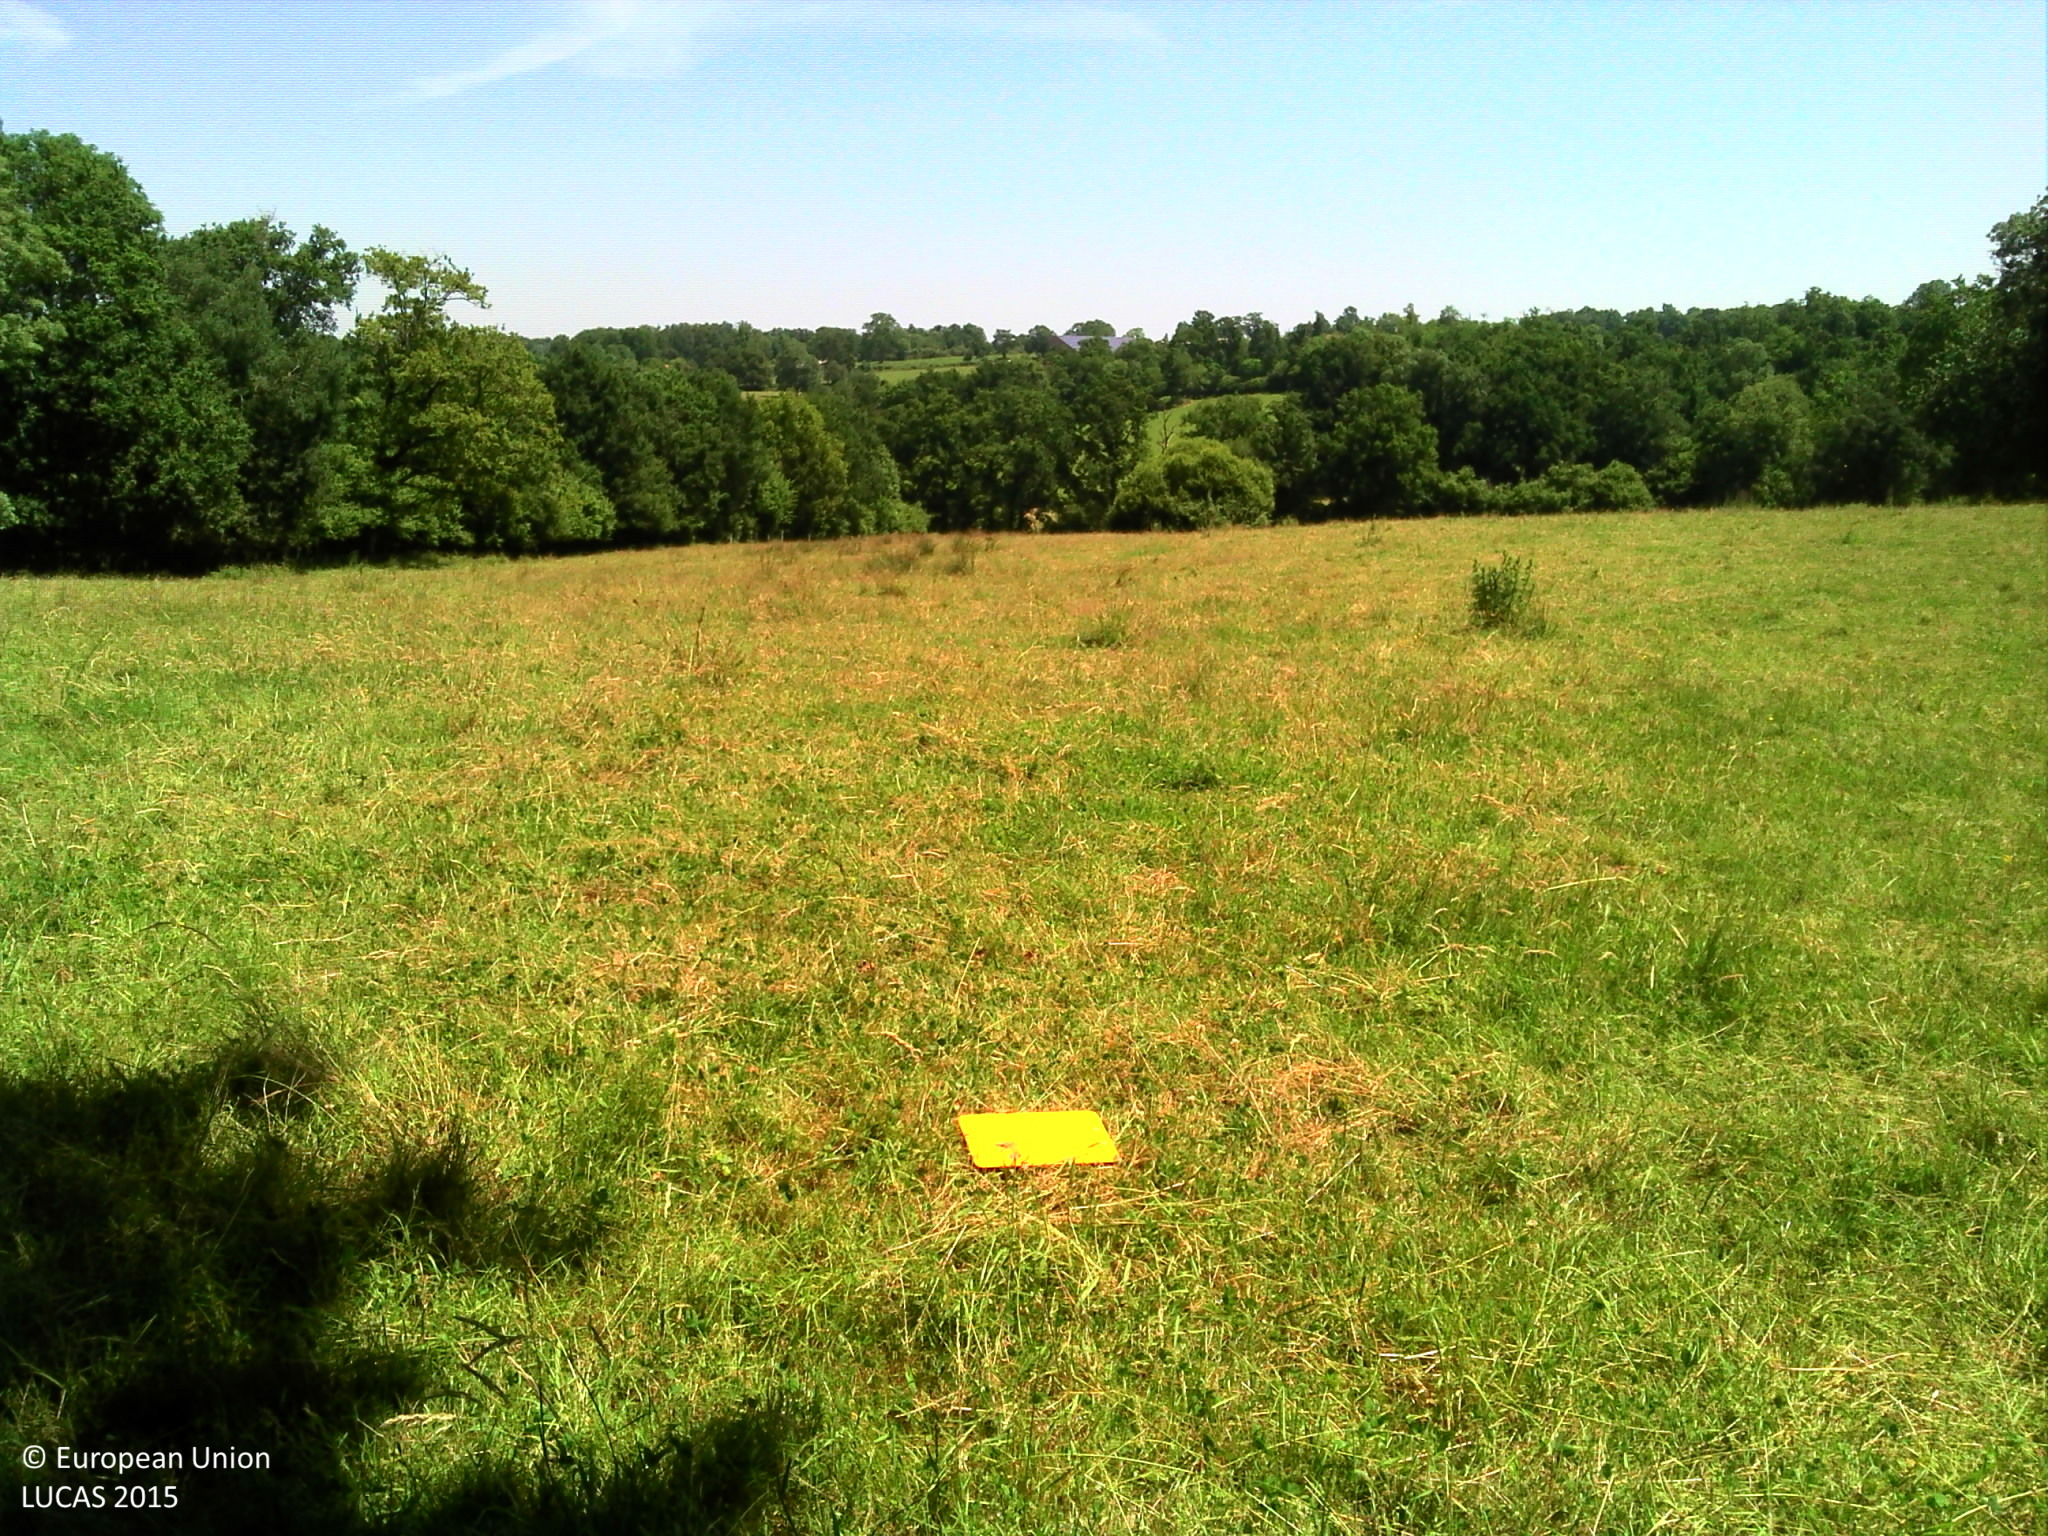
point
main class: Grassland
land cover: Grassland without tree/shrub cover
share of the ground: > 75 %
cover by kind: herbaceous plants 100 %
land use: Agriculture (excluding fallow land and kitchen gardens)
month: June
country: FR
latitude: 45.8278
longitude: 0.6022
